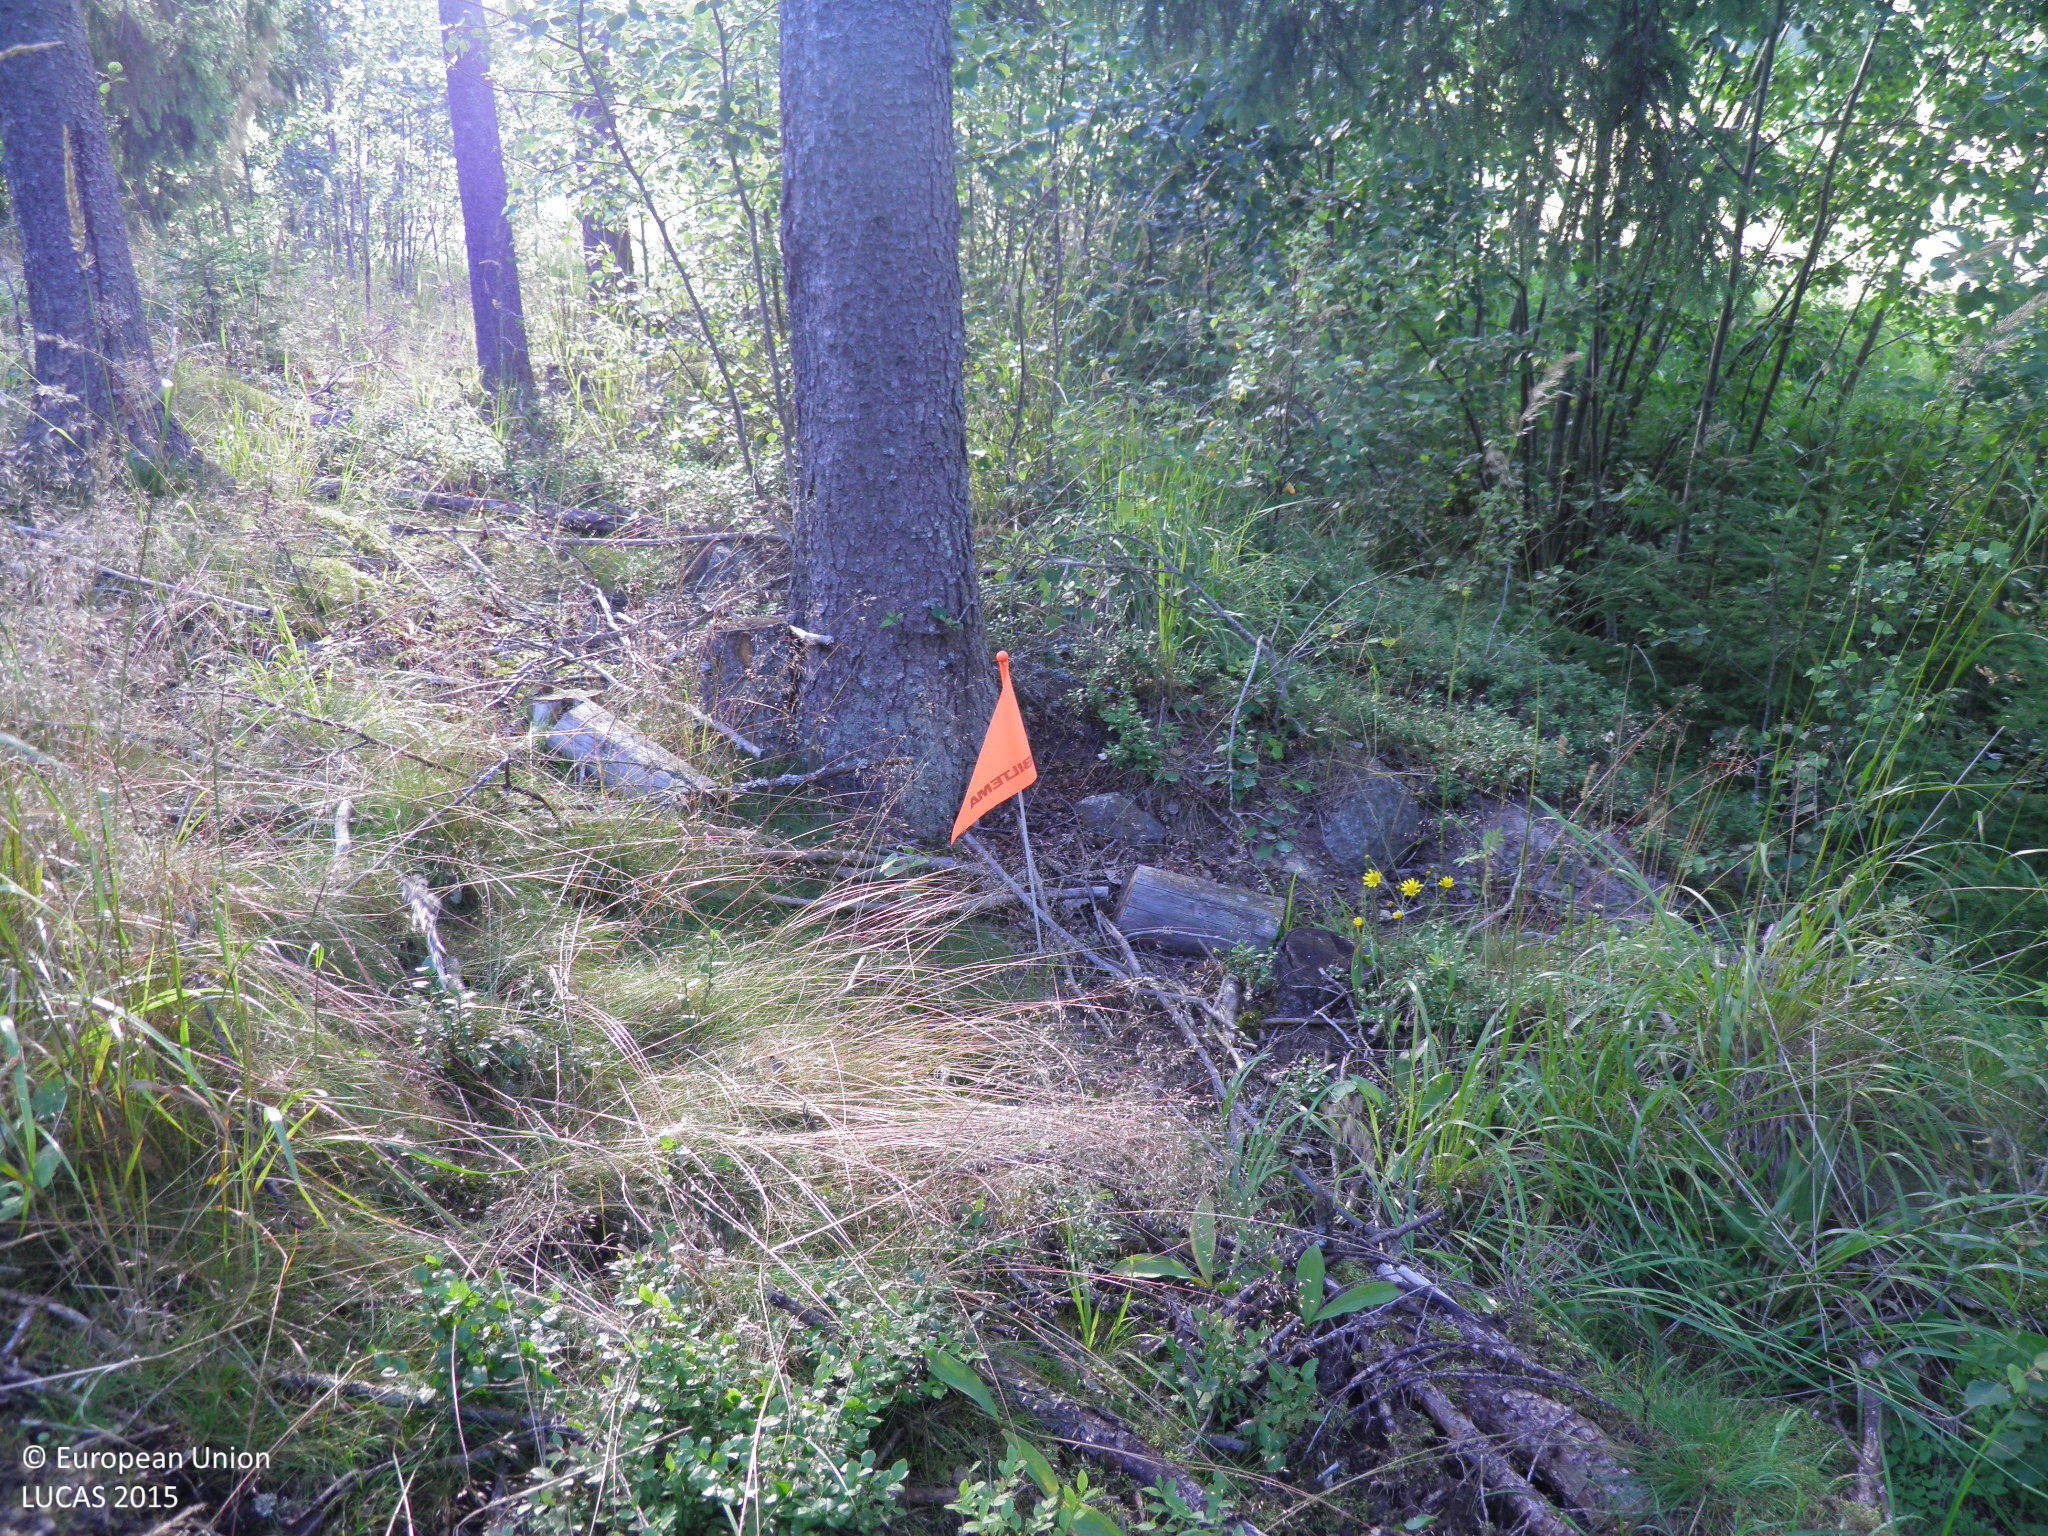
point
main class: Woodland
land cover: Spruce dominated coniferous woodland
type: hemiboreal forest and nemoral coniferous forest and mixed broadleaved-coniferous forest
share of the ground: 25 - 50 %
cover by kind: coniferous forest trees 30 %, herbaceous plants 30 %, shrubs 20 %, broadleaved forest trees 10 %, lichens and mosses 10 %
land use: Forestry
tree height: > 5 m
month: August
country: FI
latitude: 61.0231
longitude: 22.9715
